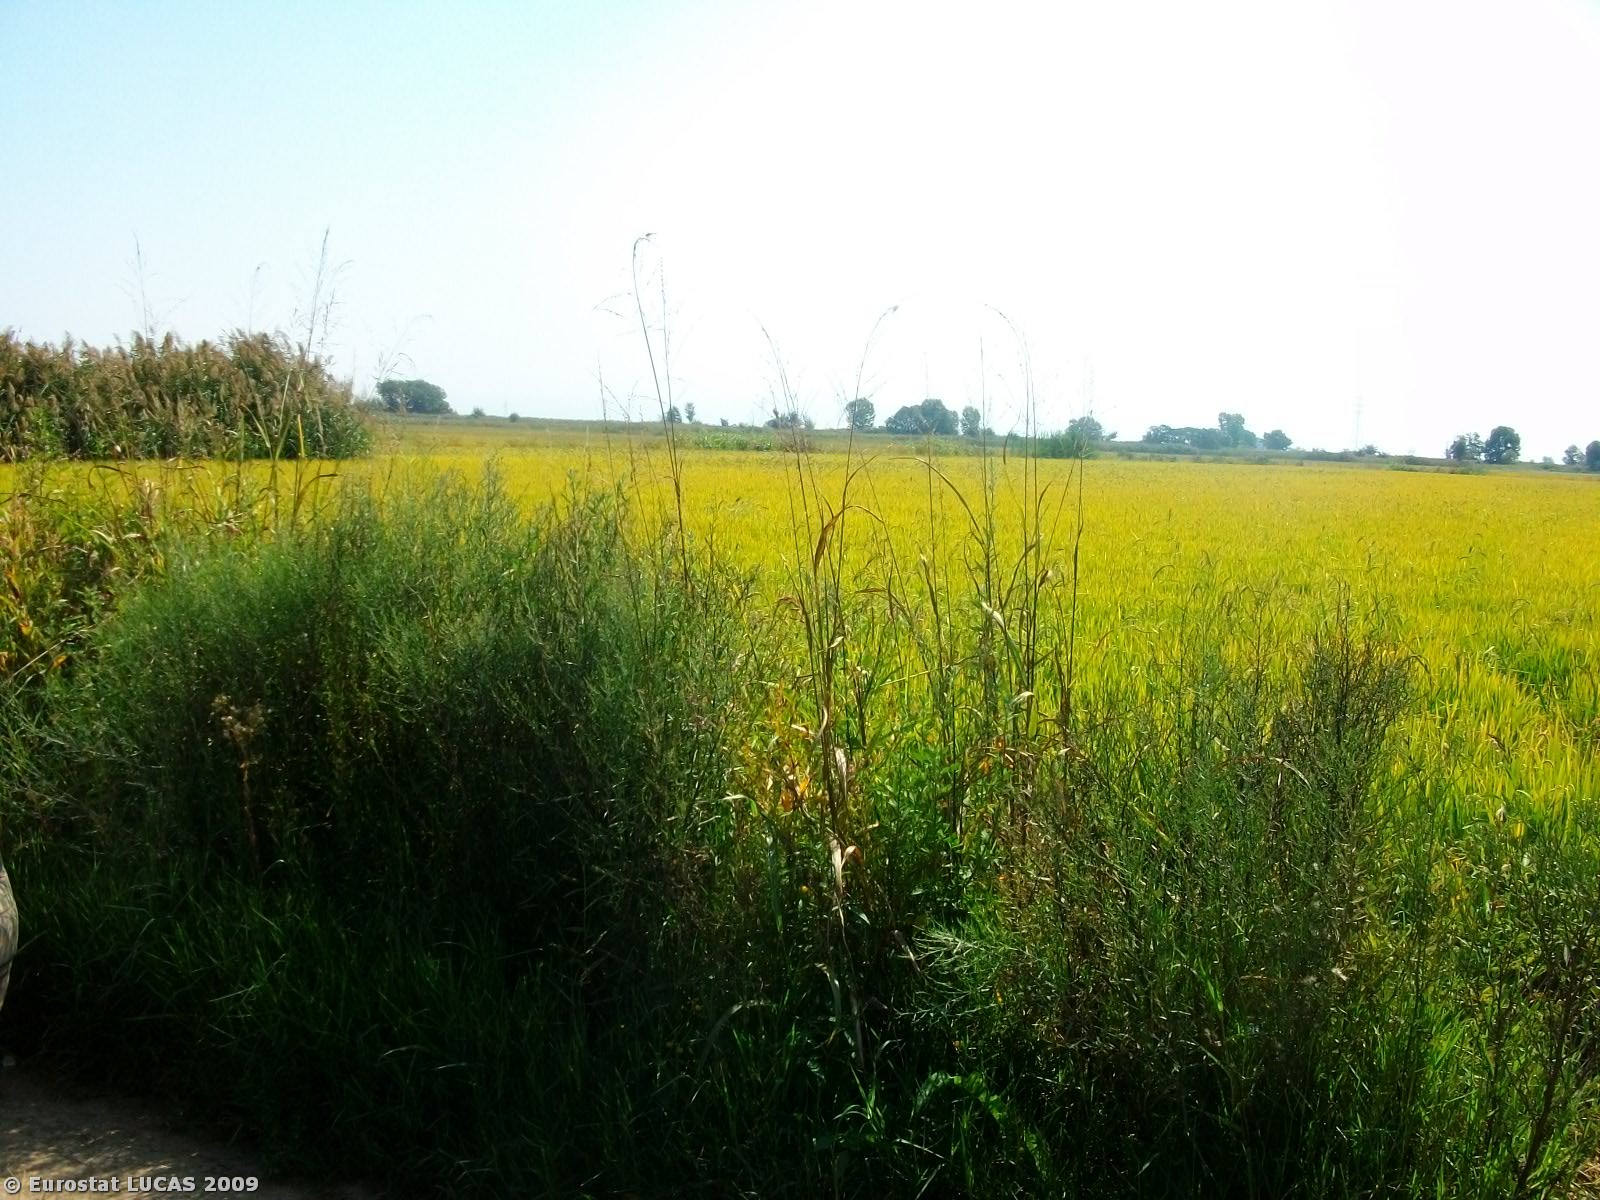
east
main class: Cropland
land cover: Rice
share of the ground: > 75 %
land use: Agriculture (excluding fallow land and kitchen gardens)
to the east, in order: Rice; Grass margins; Paved roads, cycling and walking lanes; Grass margins; Rice
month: August
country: GR
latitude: 40.6818
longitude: 22.7004
